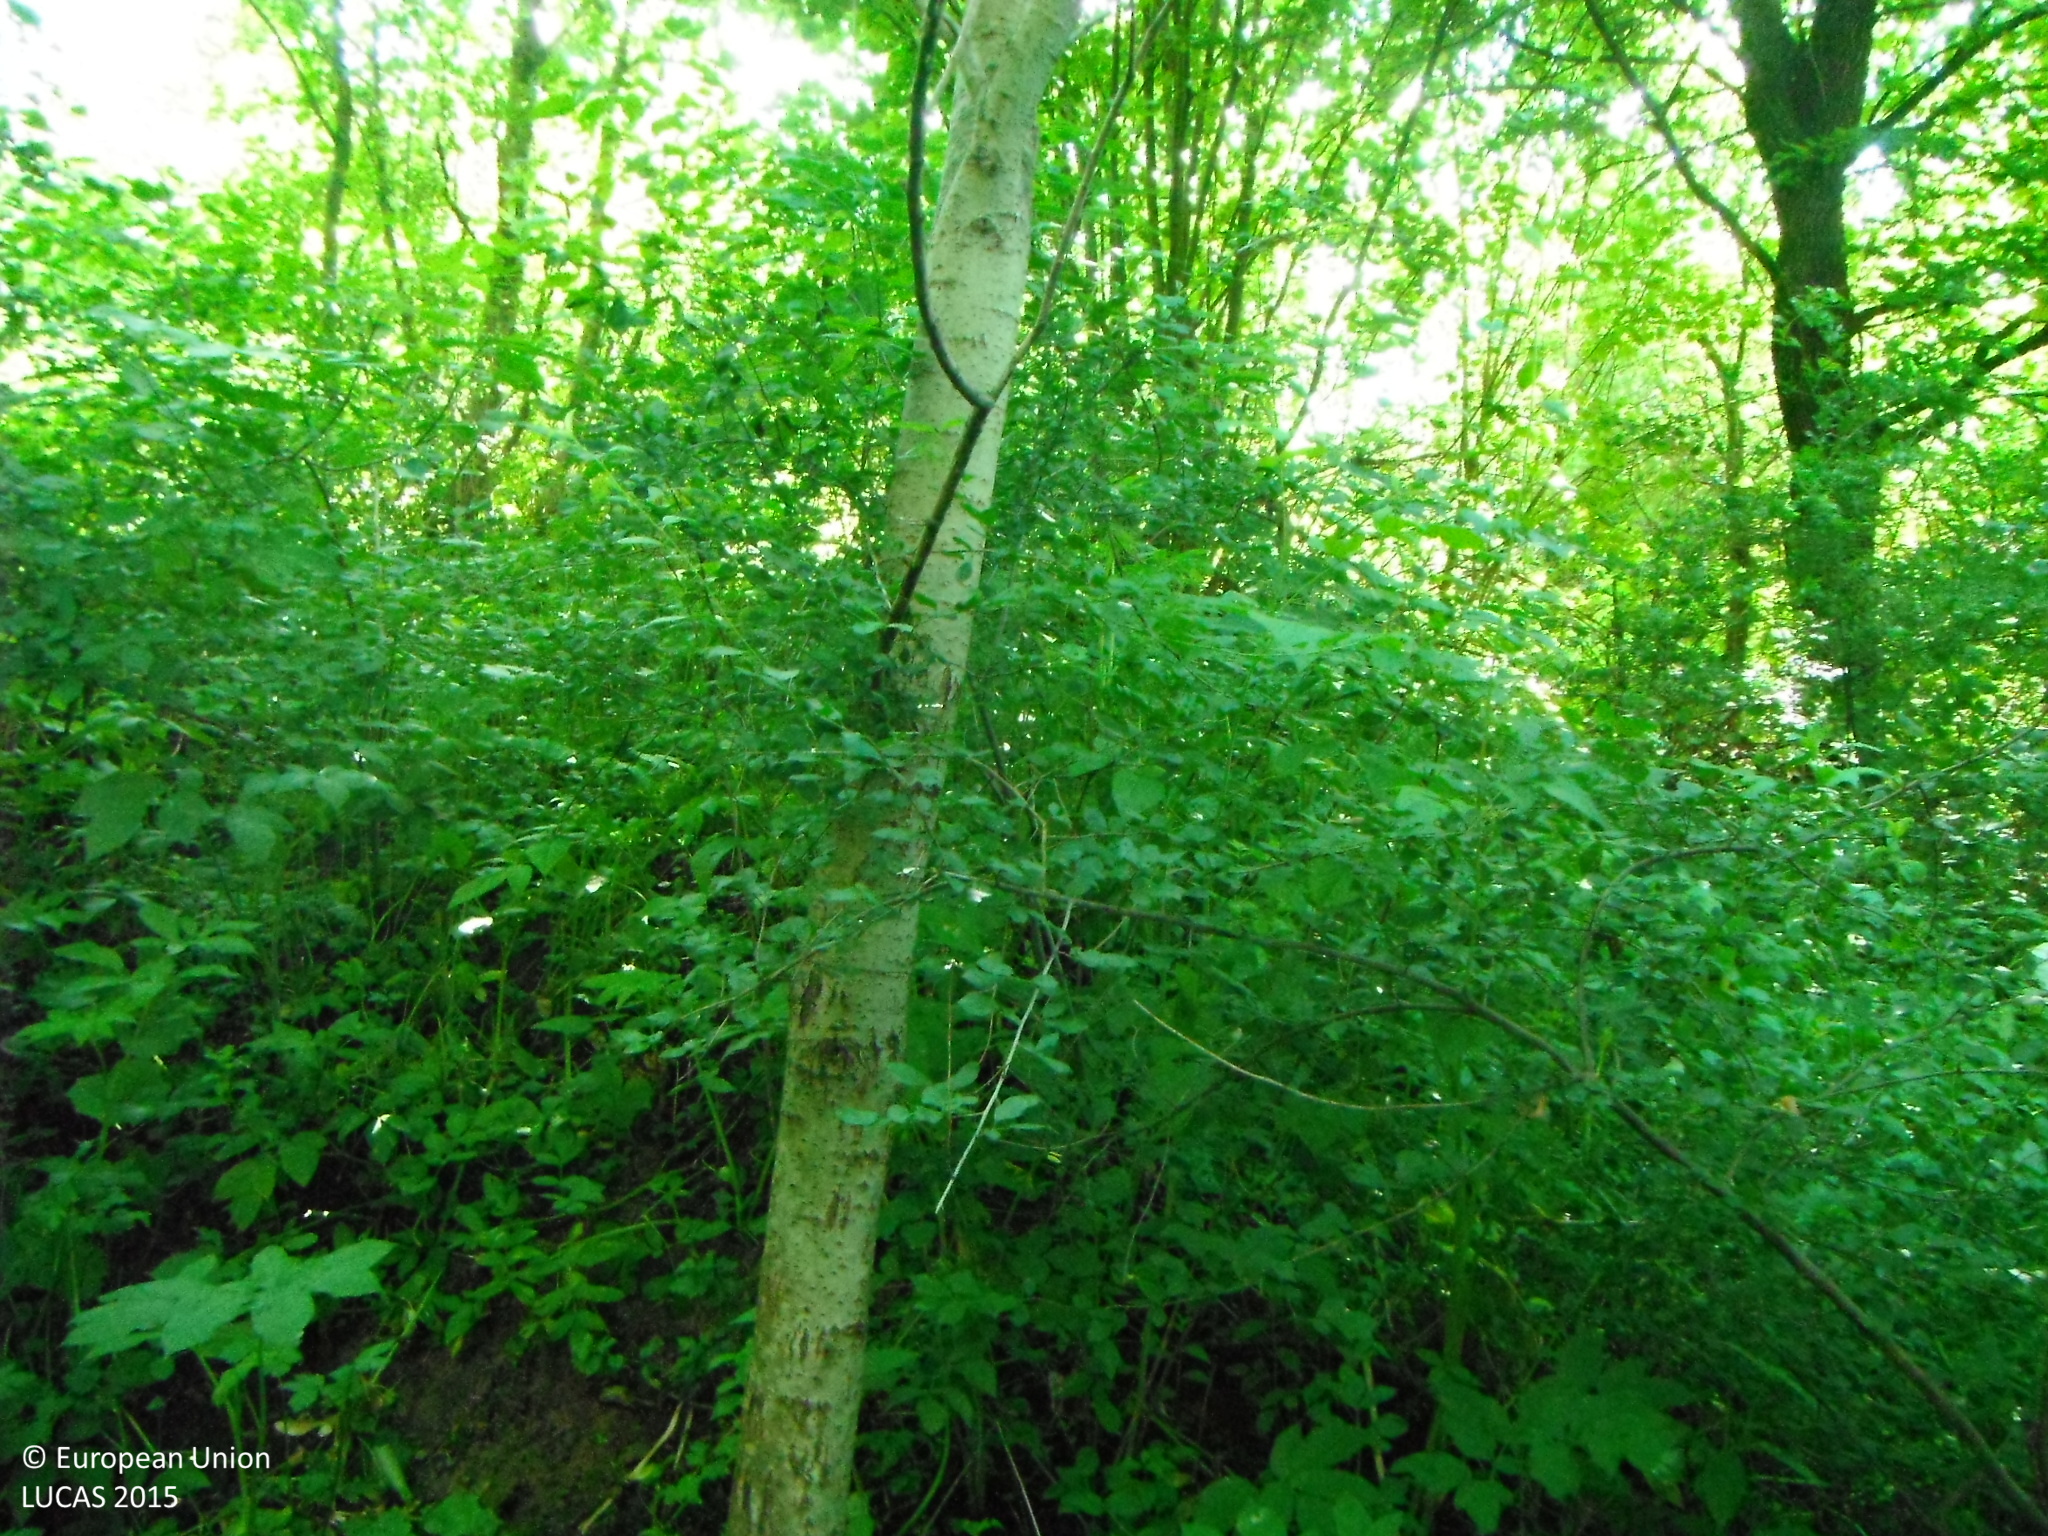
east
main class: Woodland
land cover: Broadleaved woodland
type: hemiboreal forest and nemoral coniferous forest and mixed broadleaved-coniferous forest
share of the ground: > 75 %
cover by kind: broadleaved forest trees 95 %, coniferous forest trees 5 %
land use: Semi-natural and natural areas not in use
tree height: > 5 m
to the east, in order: Broadleaved woodland; Shrubland with sparse tree cover; Grassland without tree/shrub cover; Shrubland with sparse tree cover; Grassland without tree/shrub cover; Grassland with sparse tree/shrub cover; Grassland without tree/shrub cover; Spruce dominated mixed woodland; Grassland without tree/shrub cover; Spontaneously vegetated surfaces; Grassland without tree/shrub cover
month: June
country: SK
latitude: 49.2264
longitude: 19.4871
